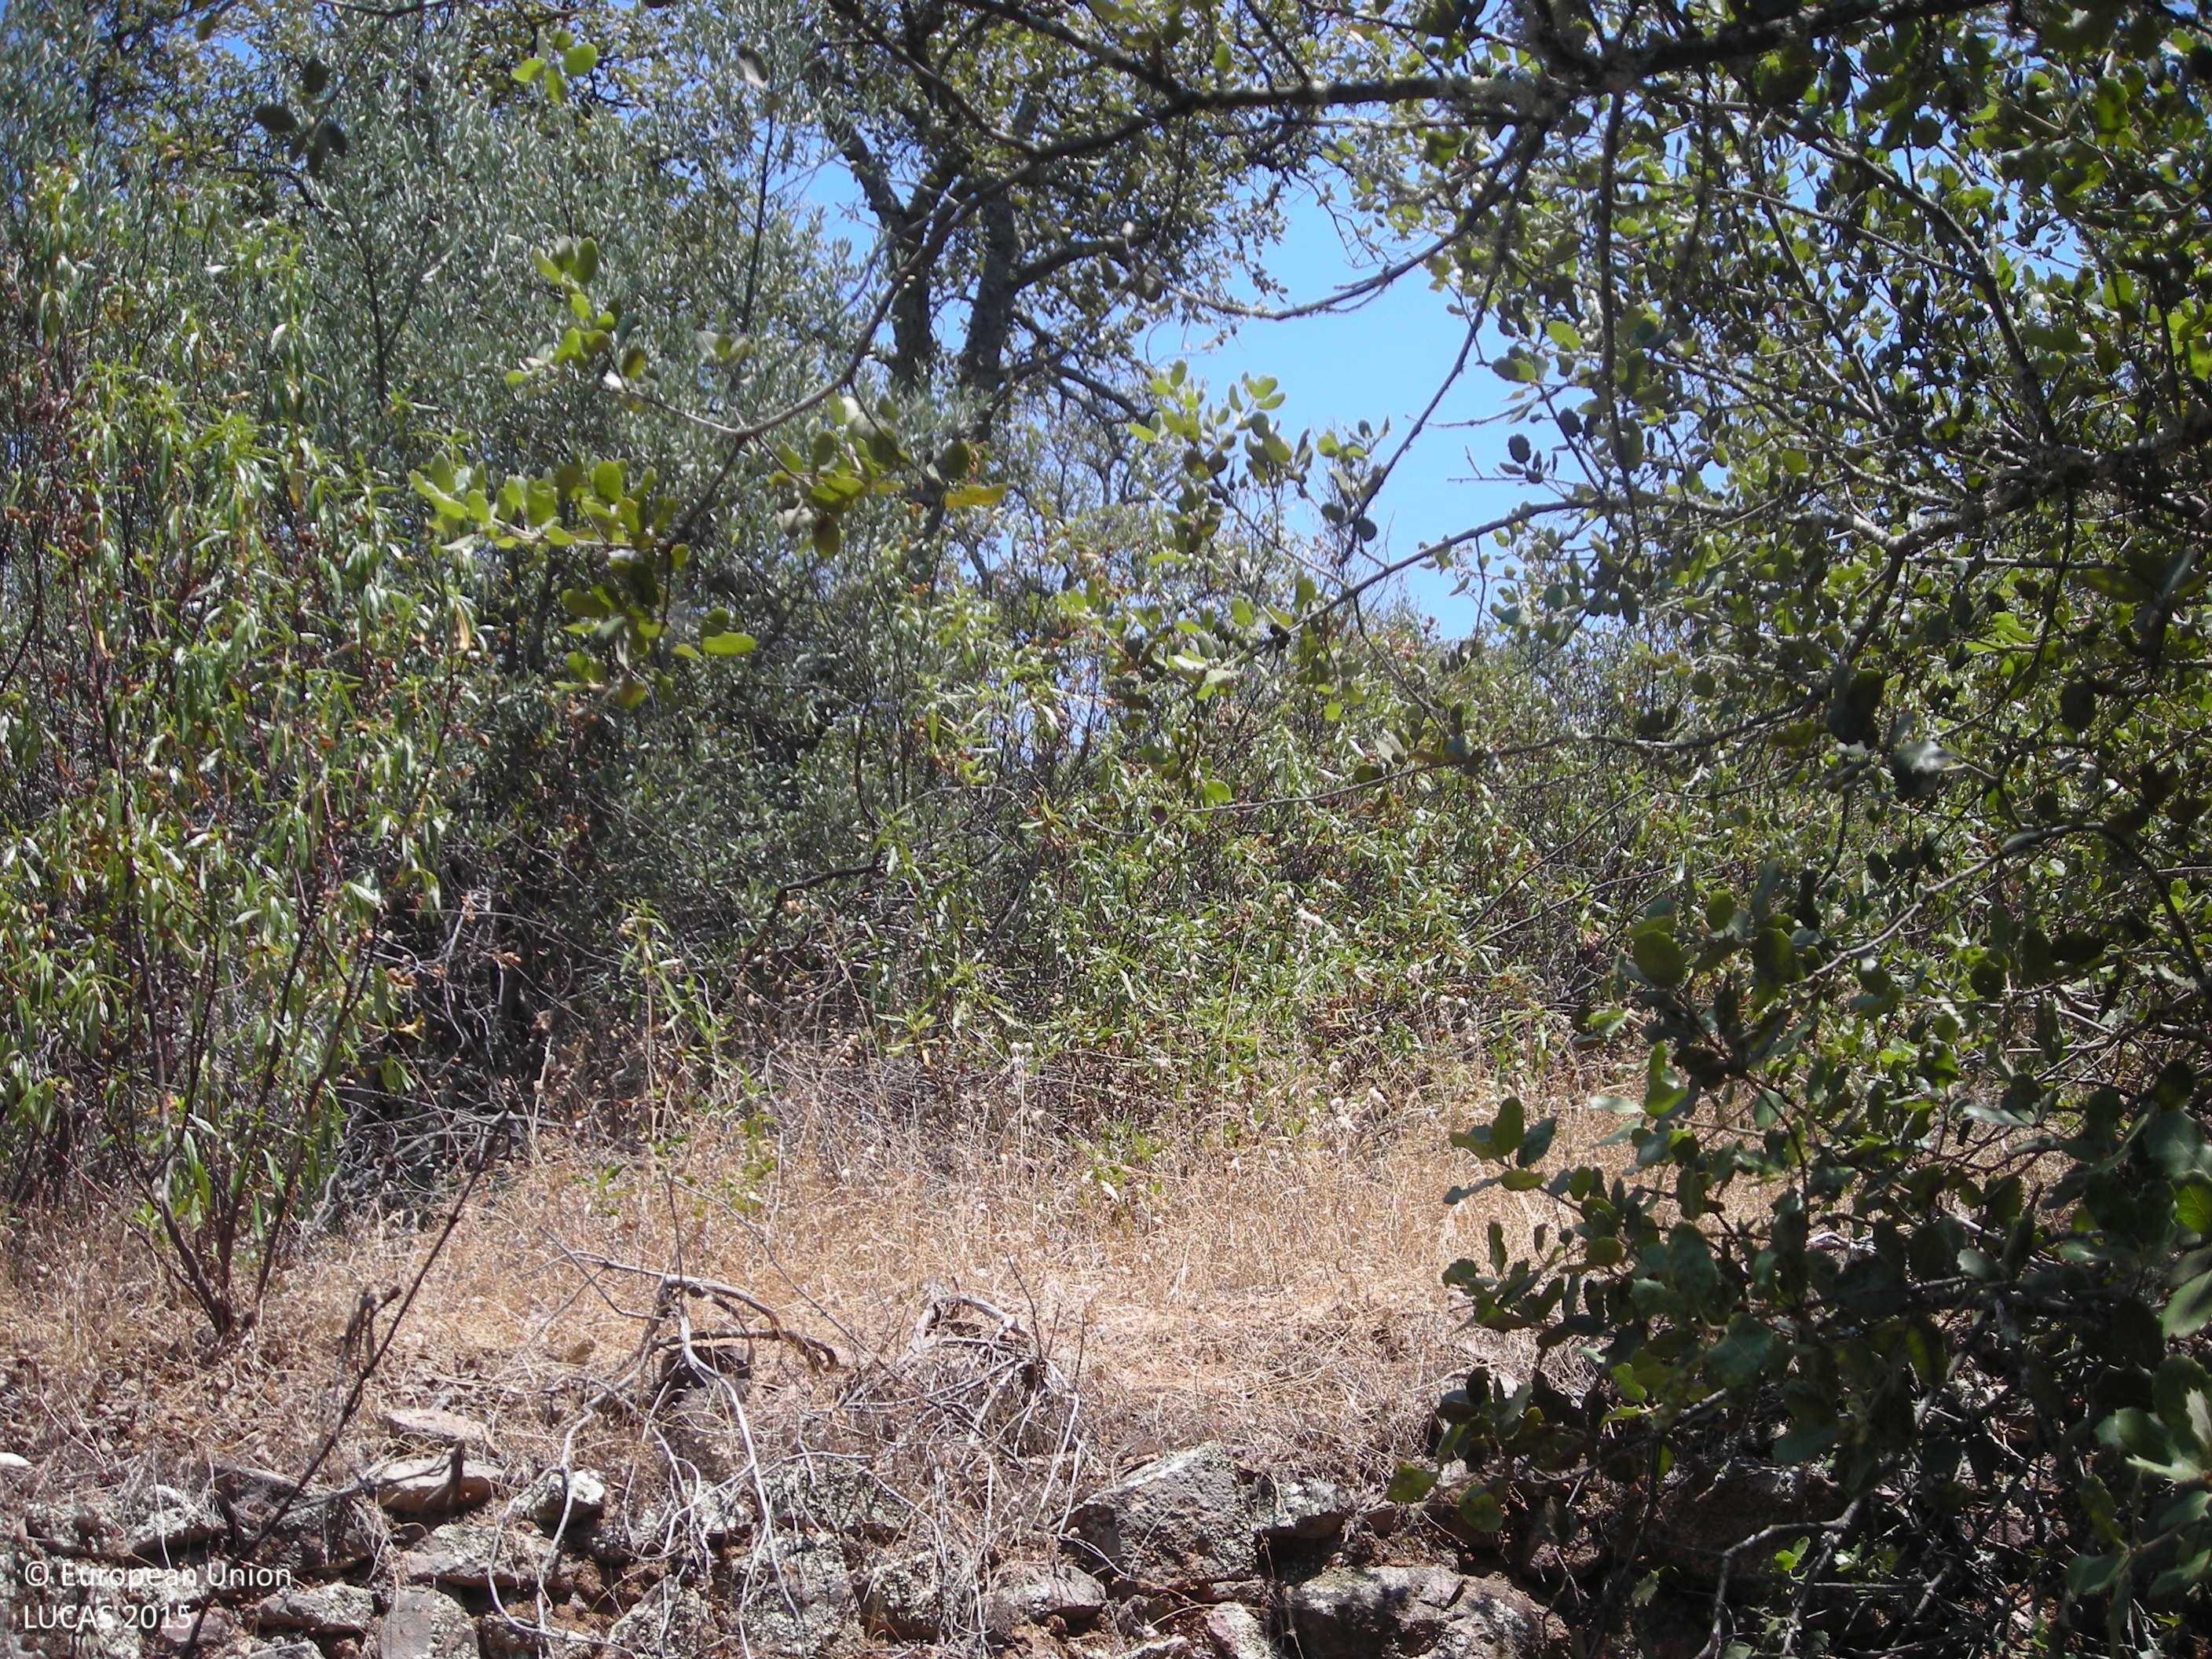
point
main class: Shrubland
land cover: Shrubland without tree cover
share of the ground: > 75 %
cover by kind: shrubs 100 %
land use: Semi-natural and natural areas not in use
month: June
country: ES
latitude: 39.0858
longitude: -5.4783
